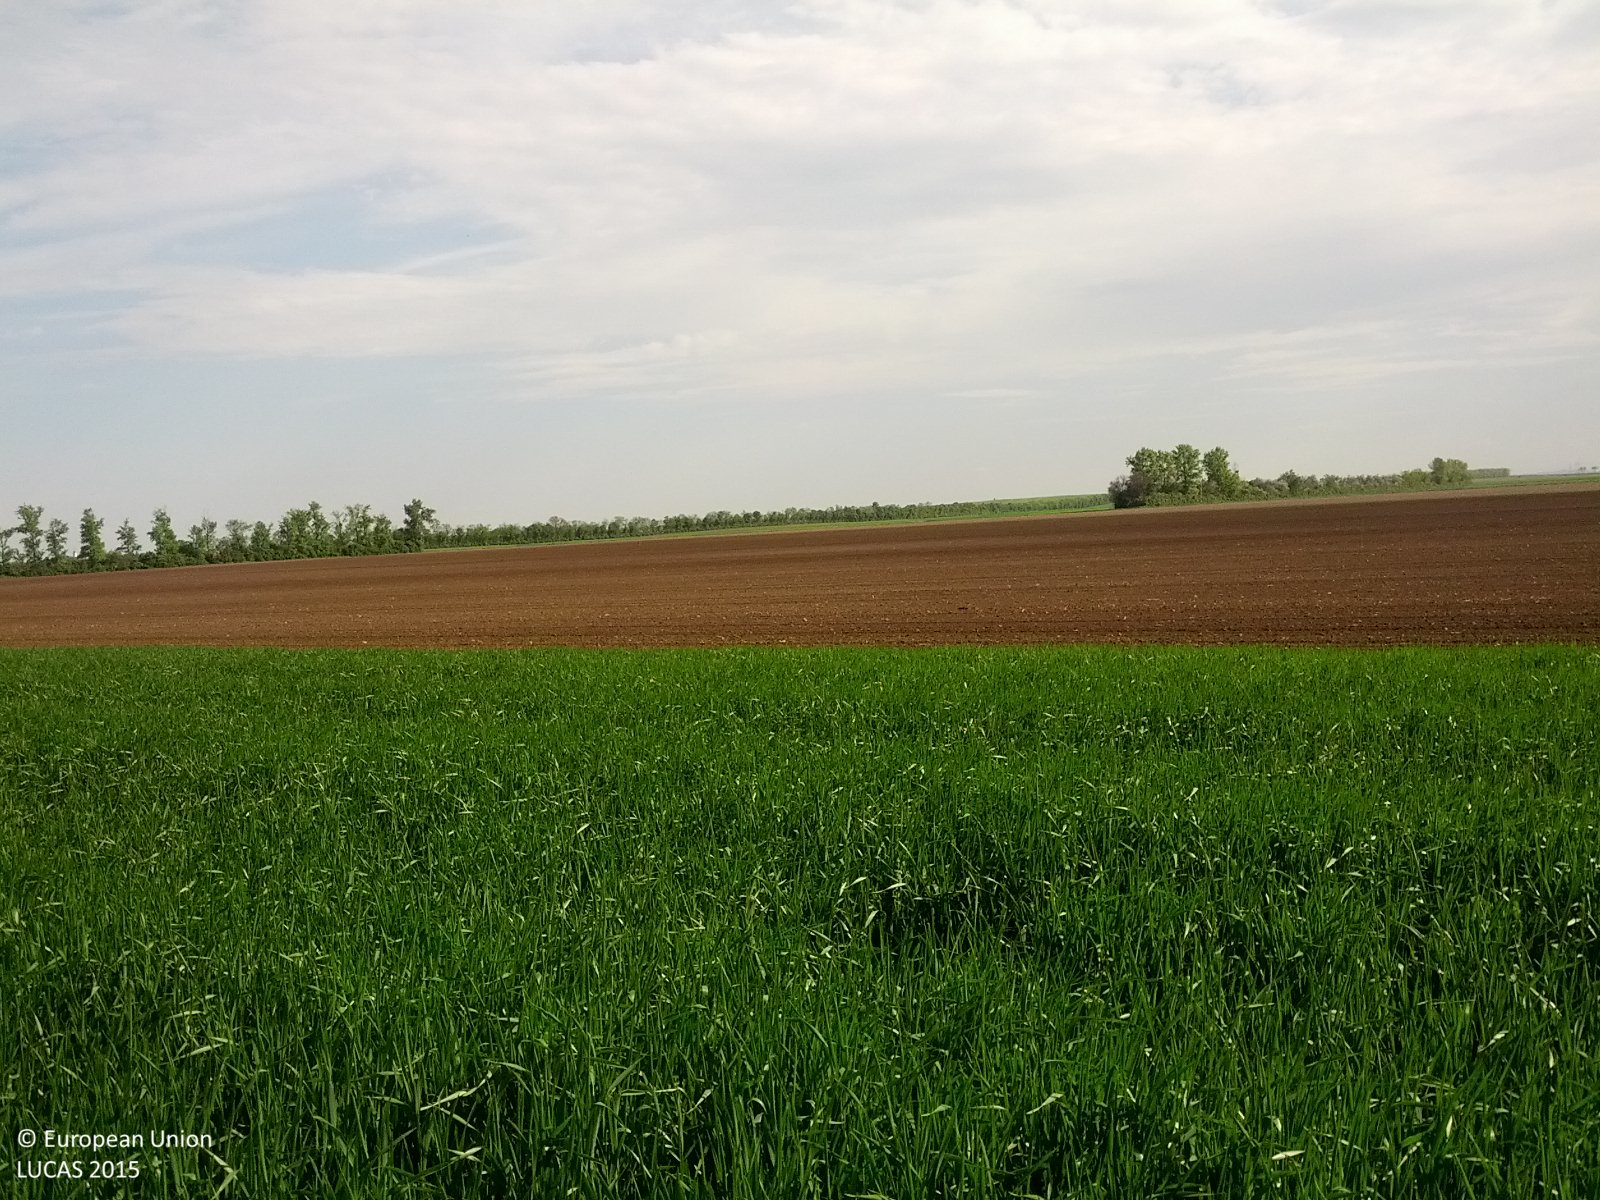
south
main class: Cropland
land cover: Barley
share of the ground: > 75 %
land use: Agriculture (excluding fallow land and kitchen gardens)
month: May
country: AT
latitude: 48.1044
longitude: 16.4917
